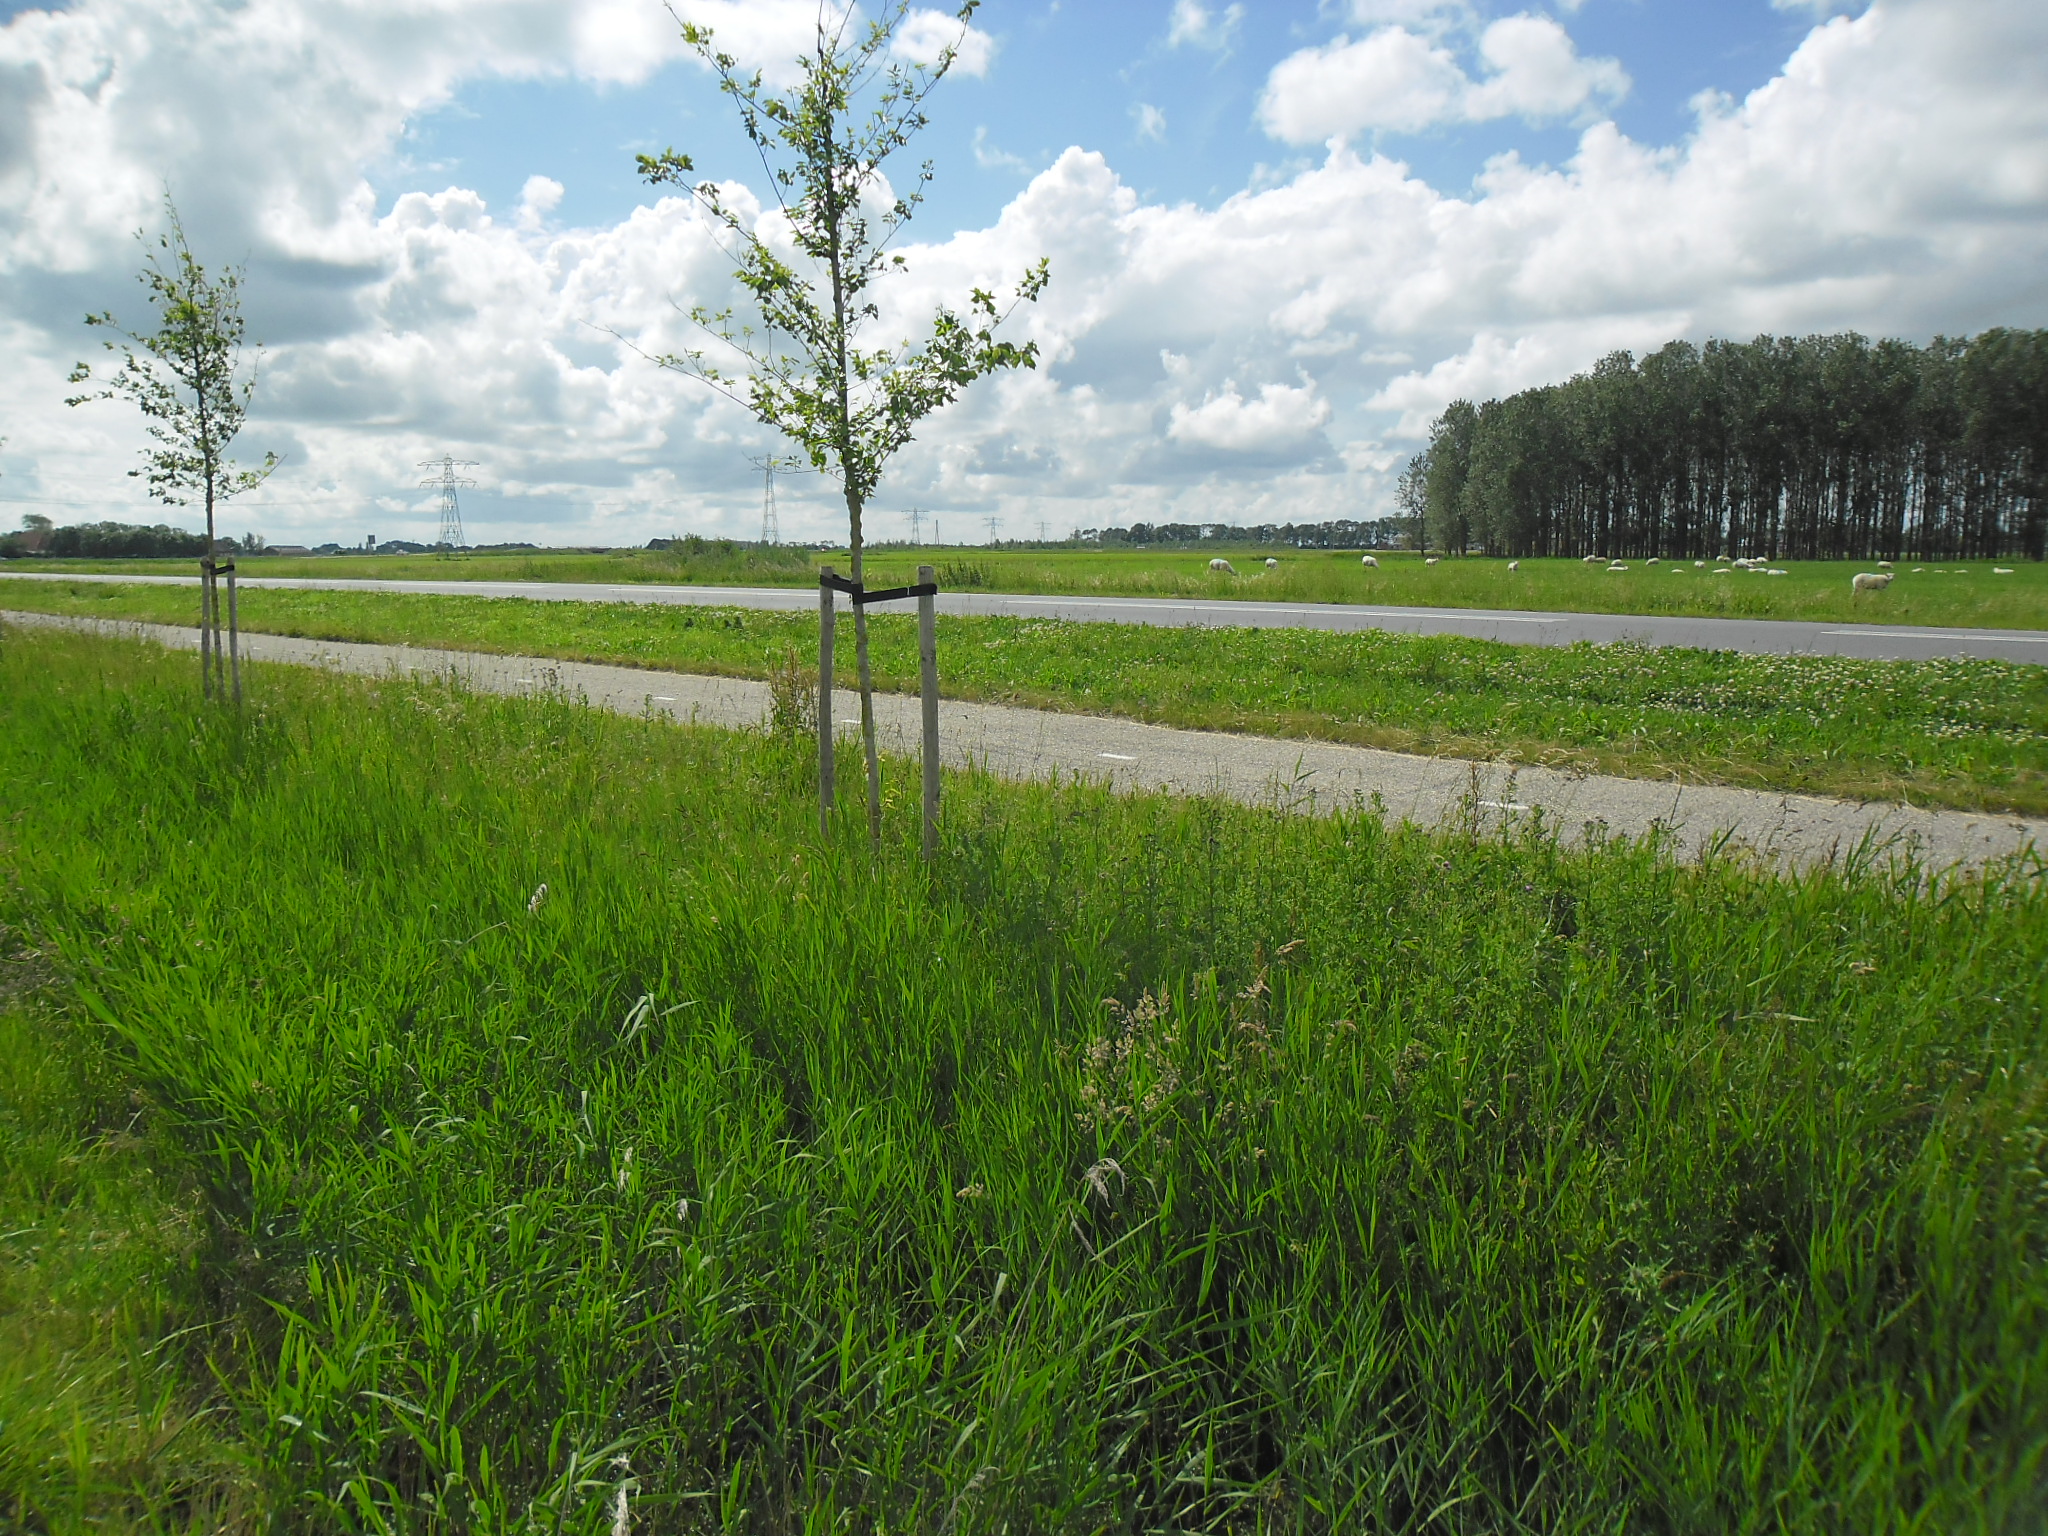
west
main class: Cropland
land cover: Maize
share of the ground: 10 - 25 %
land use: Agriculture (excluding fallow land and kitchen gardens)
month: June
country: NL
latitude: 53.1764
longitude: 5.5552
